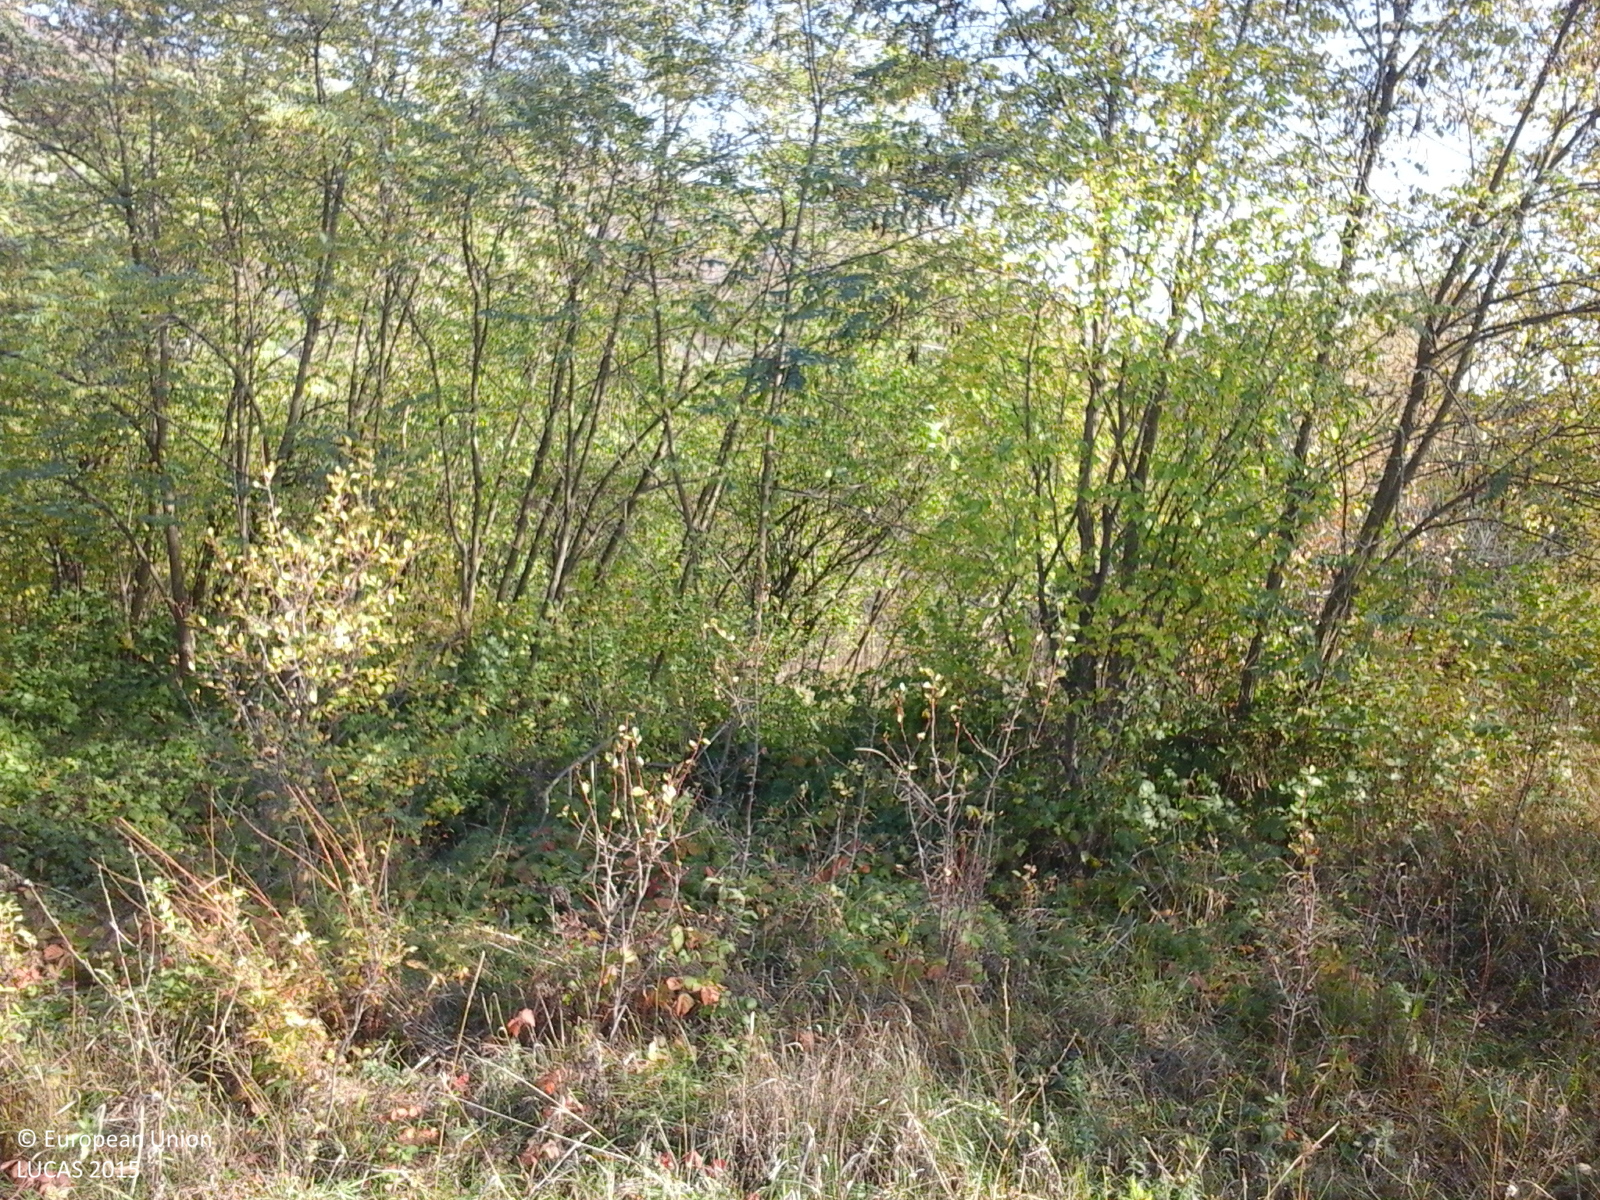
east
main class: Grassland
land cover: Grassland with sparse tree/shrub cover
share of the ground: > 75 %
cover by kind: herbaceous plants 85 %, shrubs 10 %, broadleaved forest trees 5 %
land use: Agriculture (excluding fallow land and kitchen gardens)
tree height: > 5 m
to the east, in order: Grassland with sparse tree/shrub cover; Broadleaved woodland; Grassland without tree/shrub cover; Grassland with sparse tree/shrub cover; Broadleaved woodland; Pear fruit; Other fruit trees and berries; Grassland without tree/shrub cover; Artificial constructions in urban areas; Other fresh vegetables
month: October
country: RO
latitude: 45.6070
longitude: 26.9746
